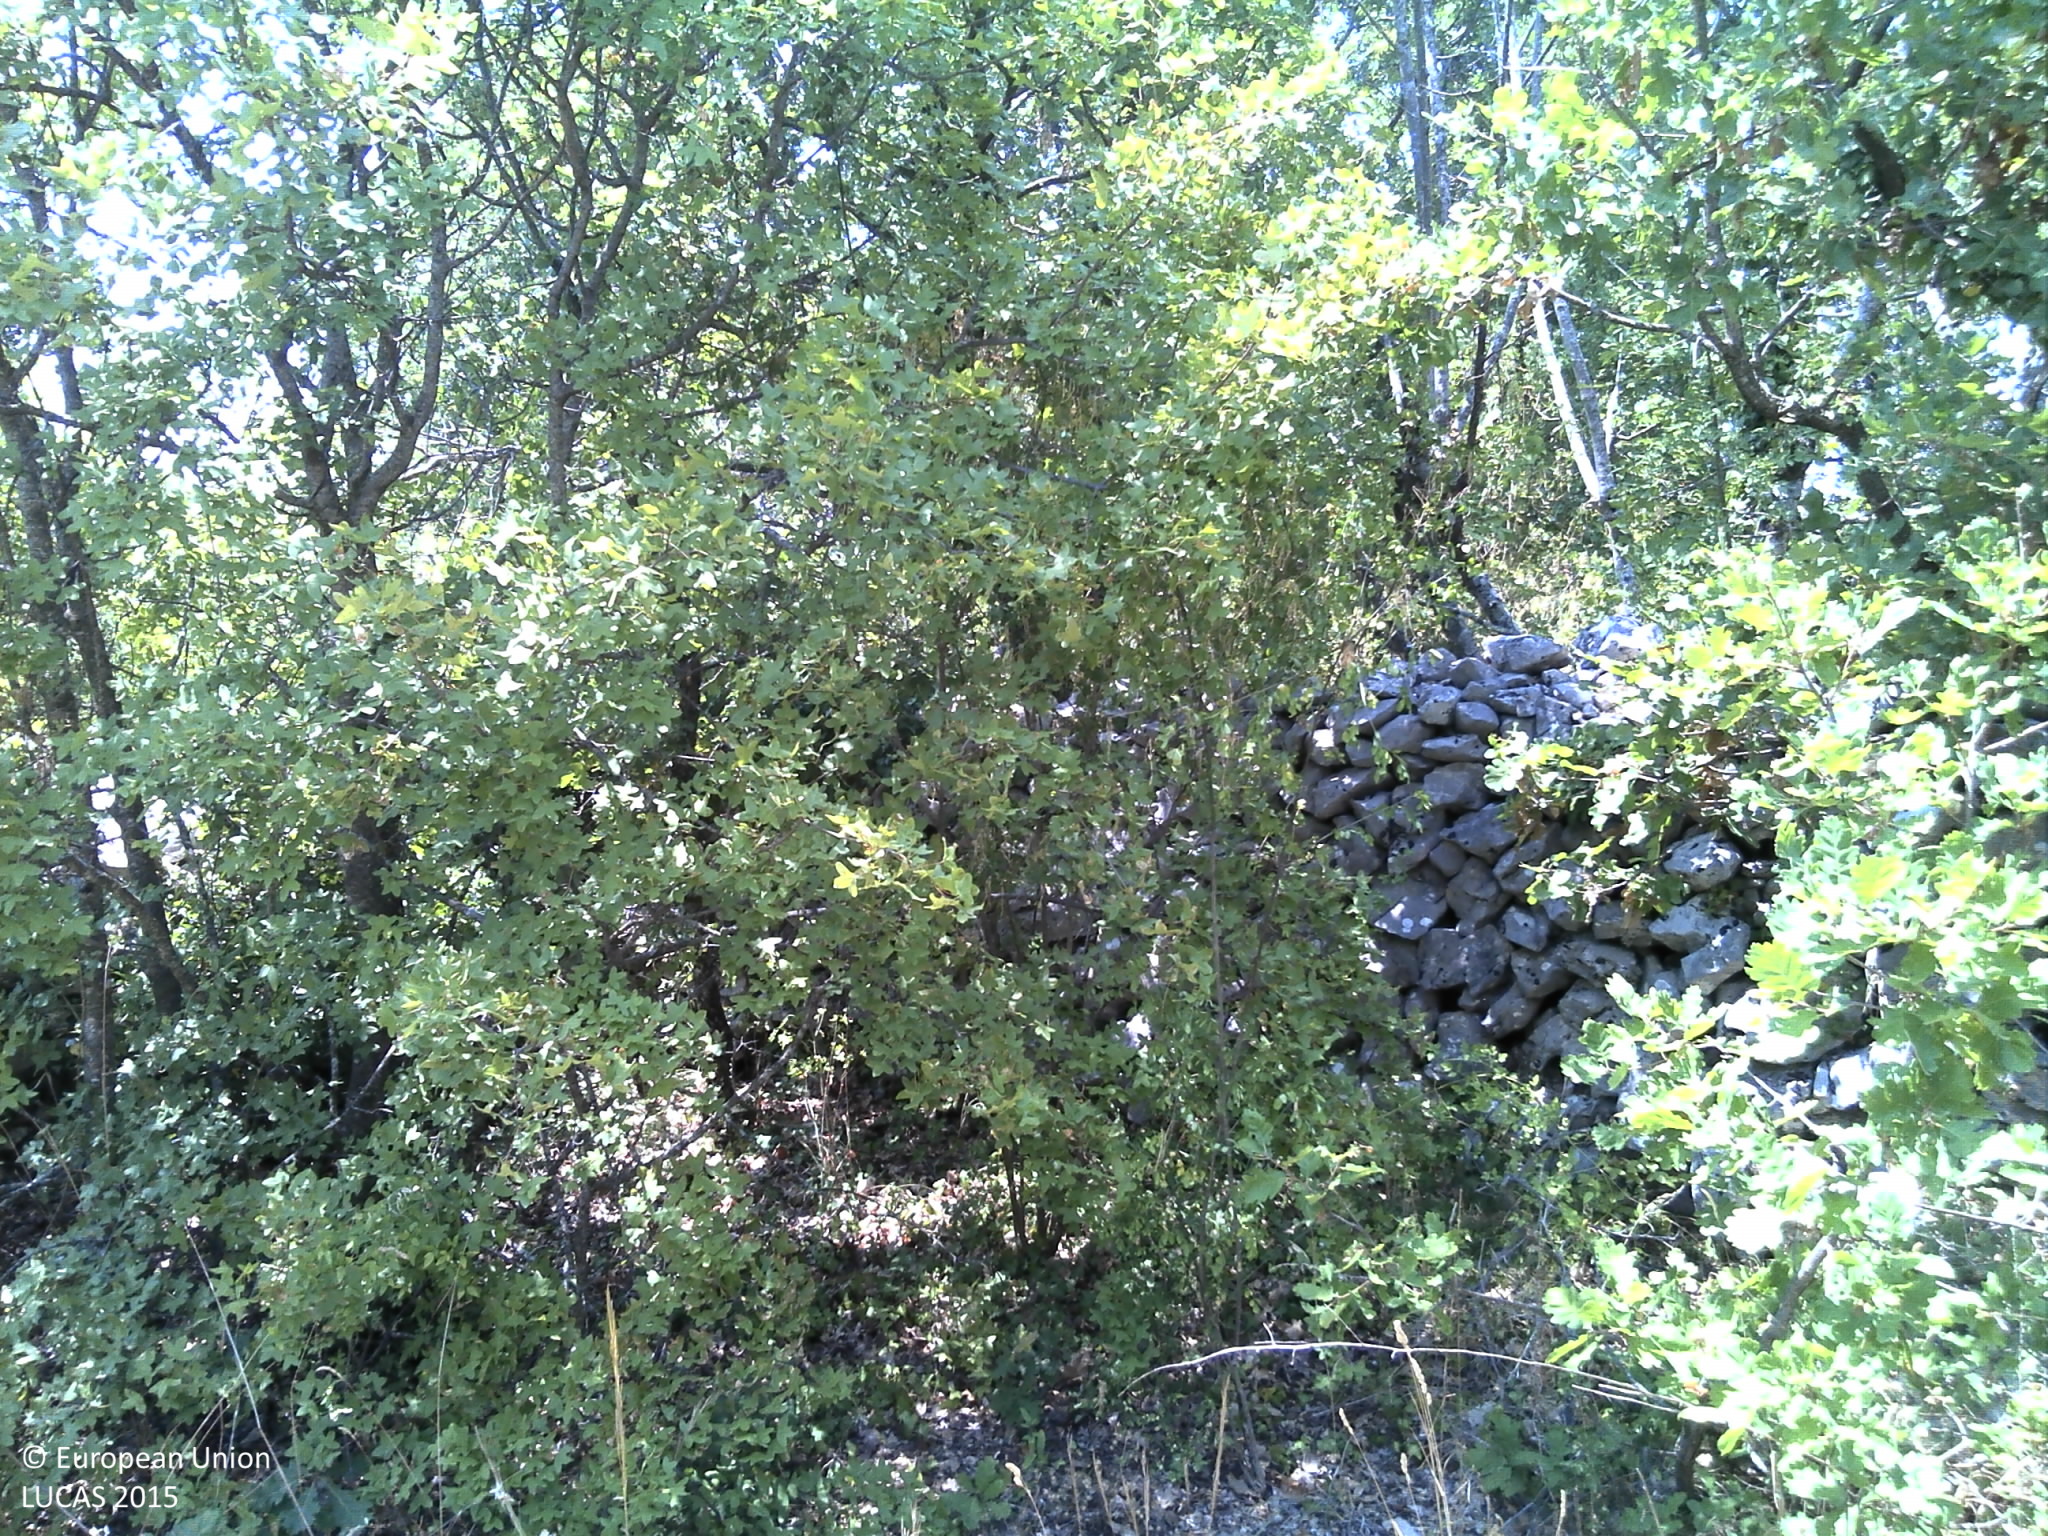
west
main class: Shrubland
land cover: Shrubland with sparse tree cover
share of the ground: > 75 %
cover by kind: shrubs 60 %, herbaceous plants 15 %, unconsolidated bare surface 15 %, broadleaved forest trees 5 %, consolidated bare surface 5 %
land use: Semi-natural and natural areas not in use
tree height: > 5 m
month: July
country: HR
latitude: 43.4820
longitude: 16.9771
